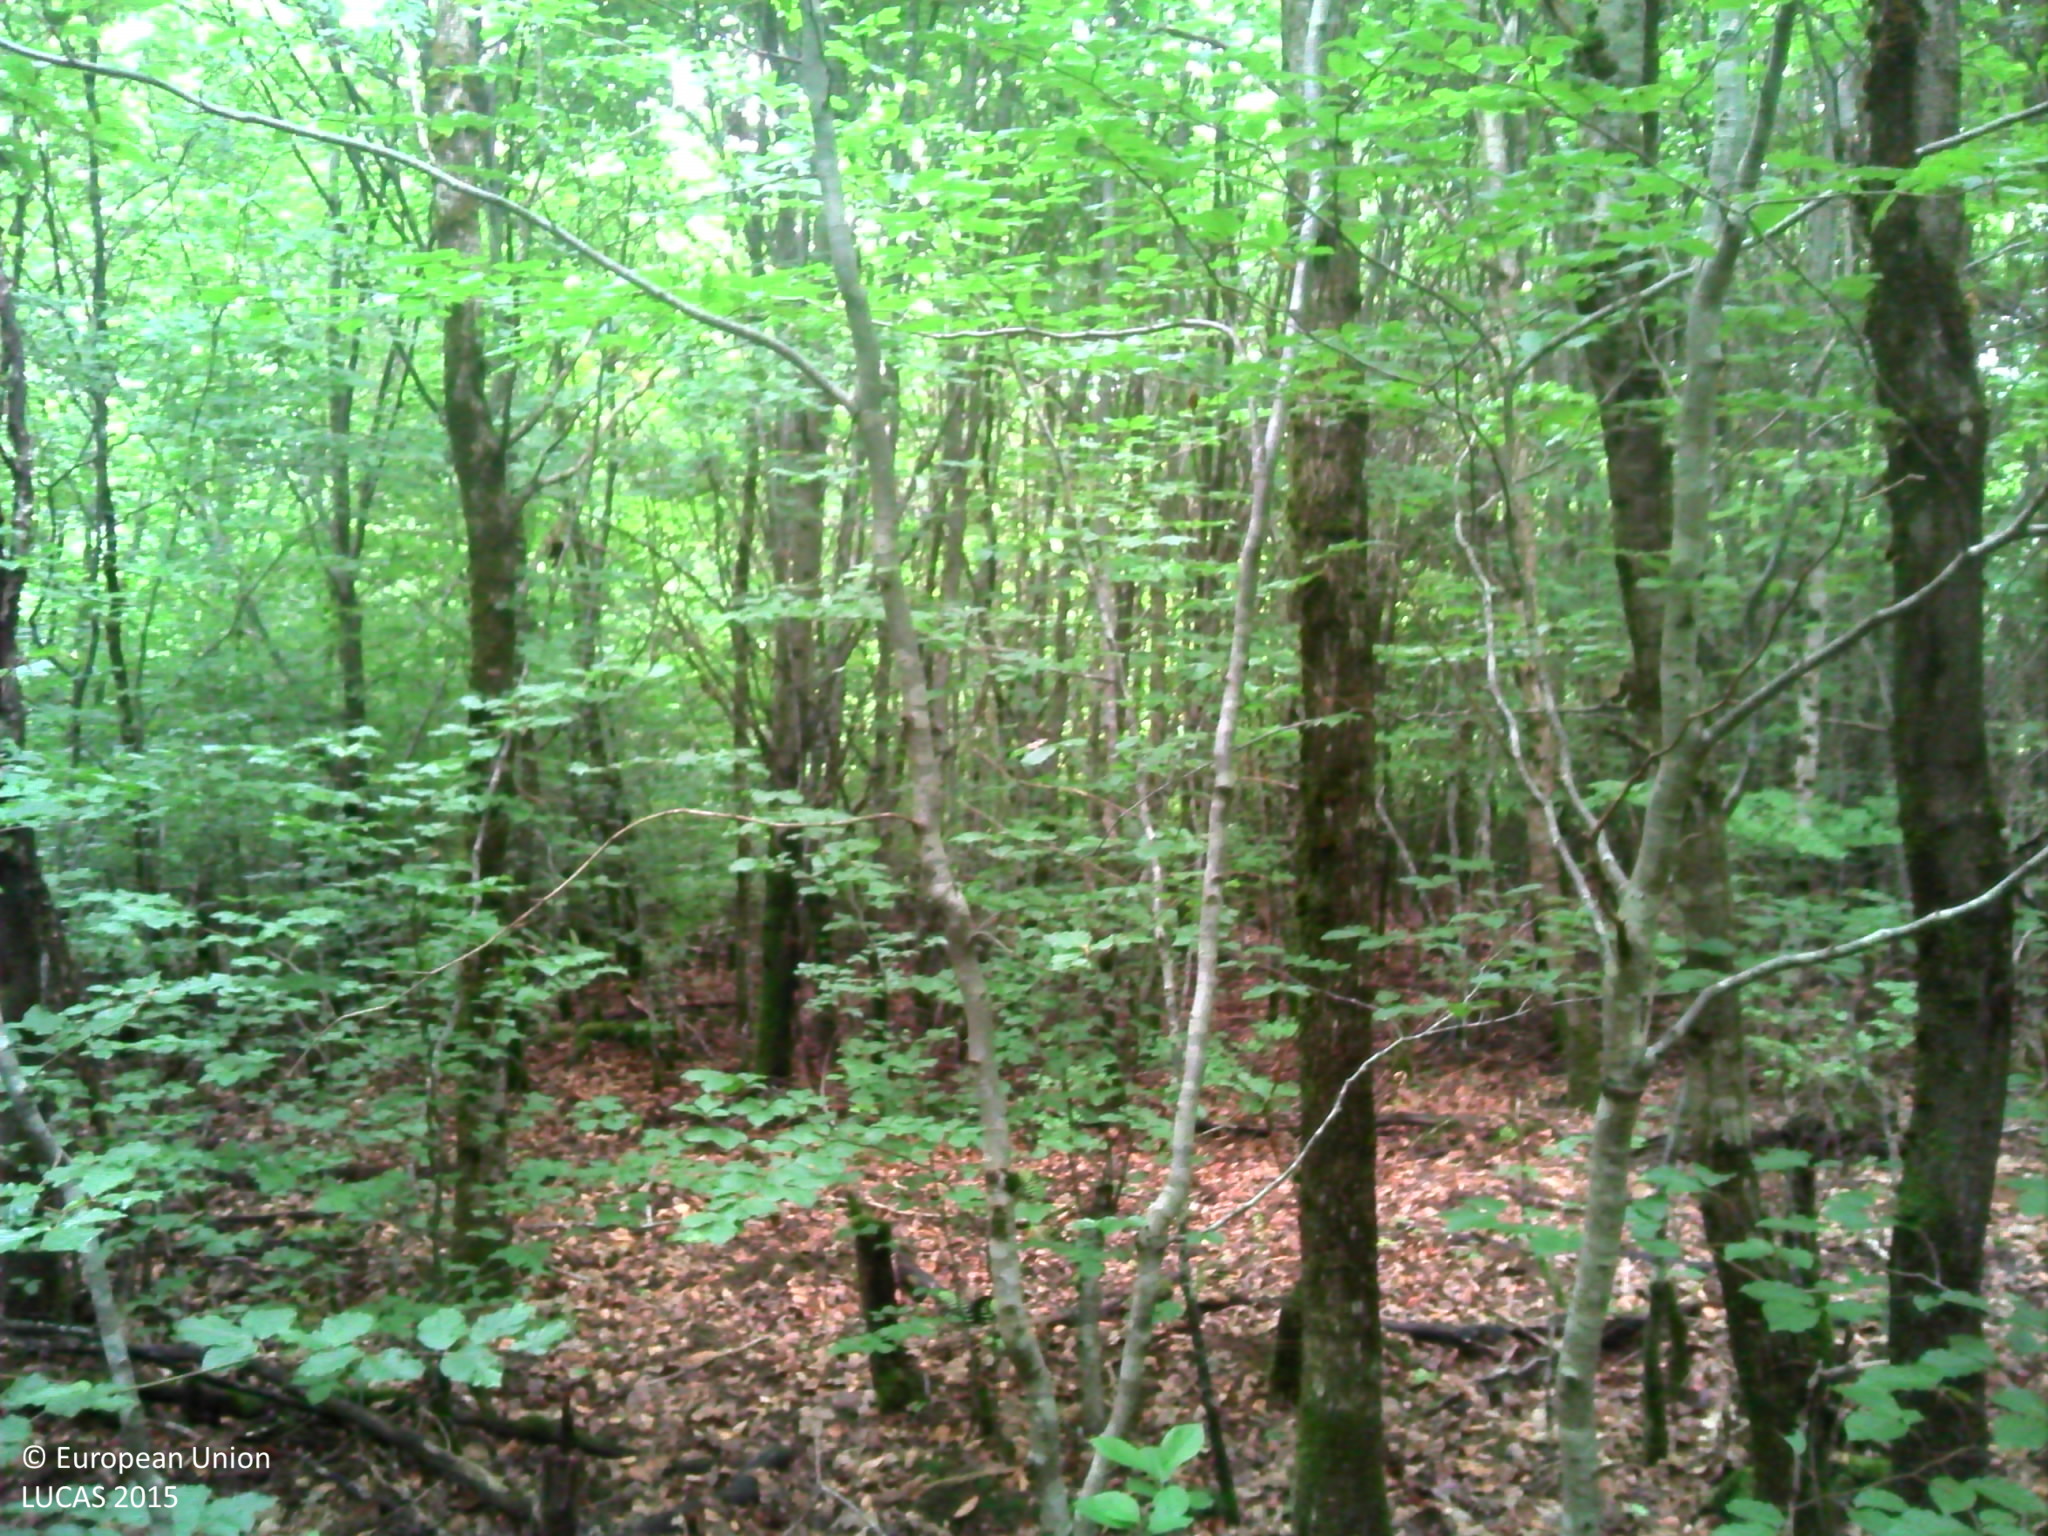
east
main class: Woodland
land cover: Broadleaved woodland
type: beech forest
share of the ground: > 75 %
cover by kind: broadleaved forest trees 90 %, unconsolidated bare surface 10 %
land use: Forestry
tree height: > 5 m
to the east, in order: Broadleaved woodland; Tracks; Broadleaved woodland
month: June
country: FR
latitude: 47.9109
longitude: 6.3483
